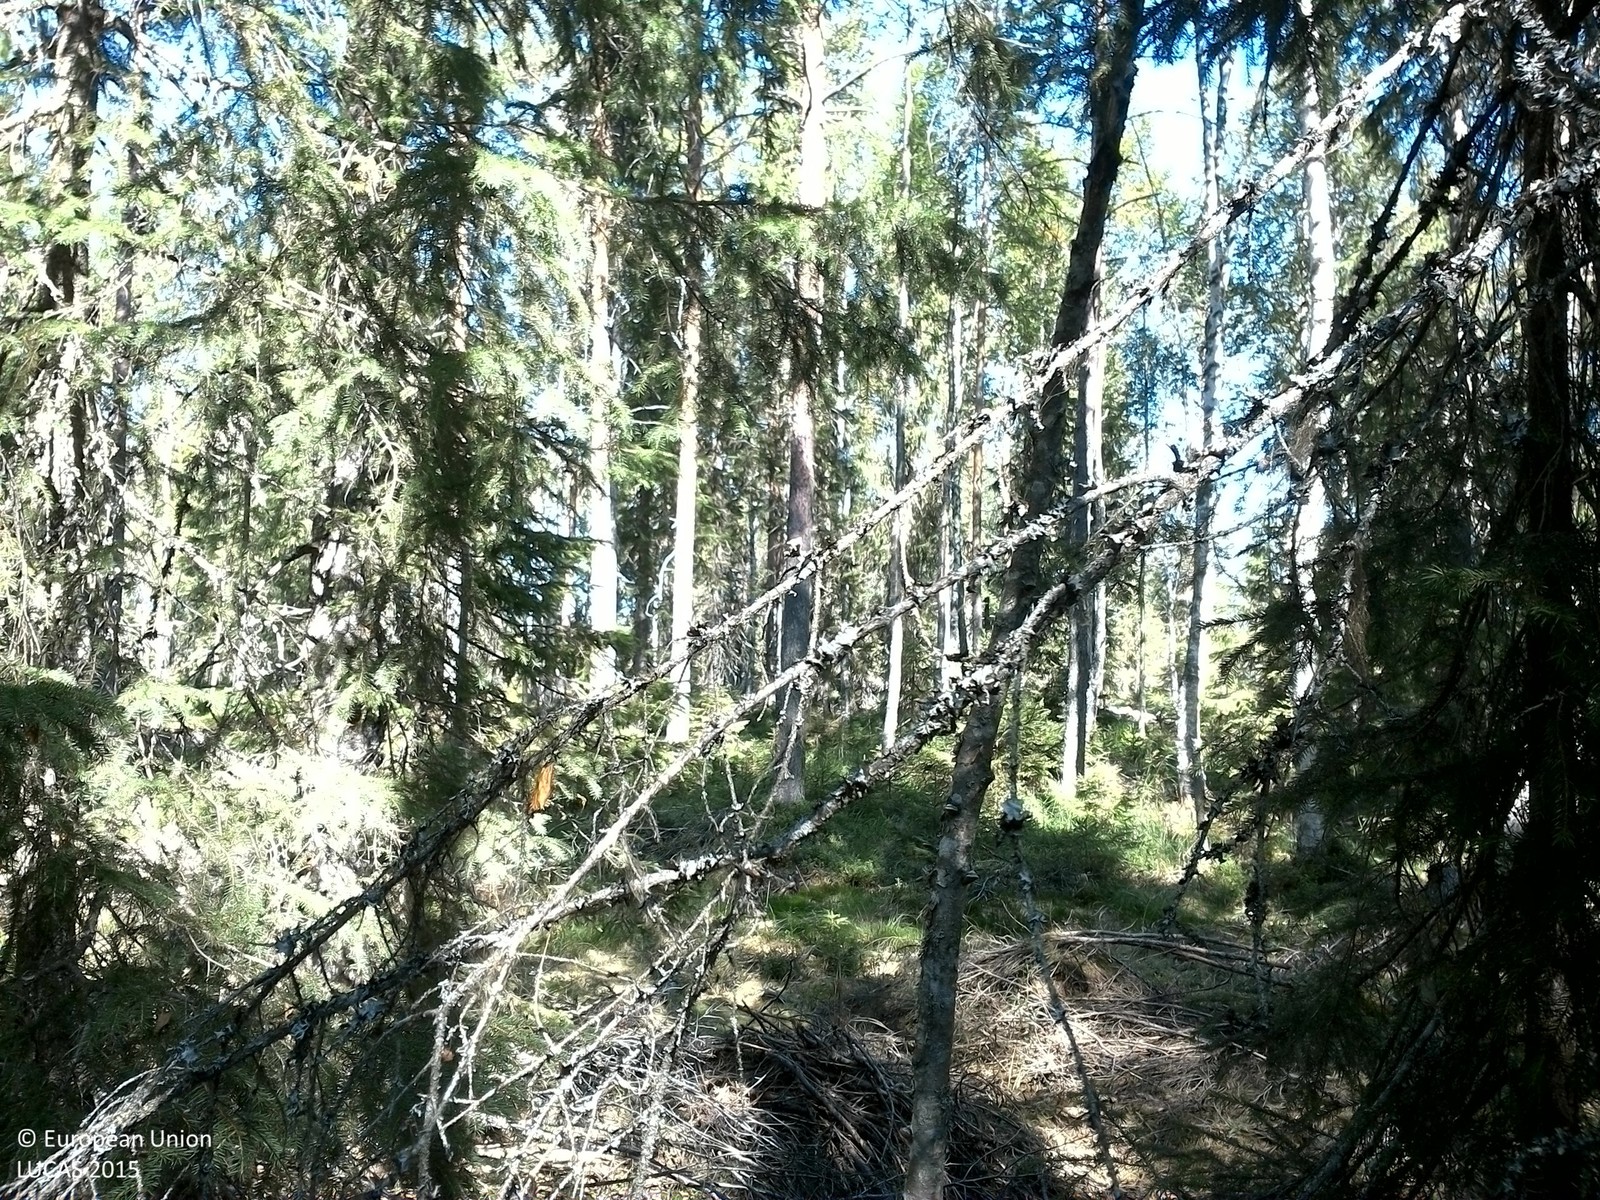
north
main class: Woodland
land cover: Spruce dominated mixed woodland
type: boreal forest
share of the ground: 50 - 75 %
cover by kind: coniferous forest trees 40 %, broadleaved forest trees 30 %, lichens and mosses 15 %, shrubs 10 %, herbaceous plants 5 %
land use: Forestry
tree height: > 5 m
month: August
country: SE
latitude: 63.7052
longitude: 17.2766
